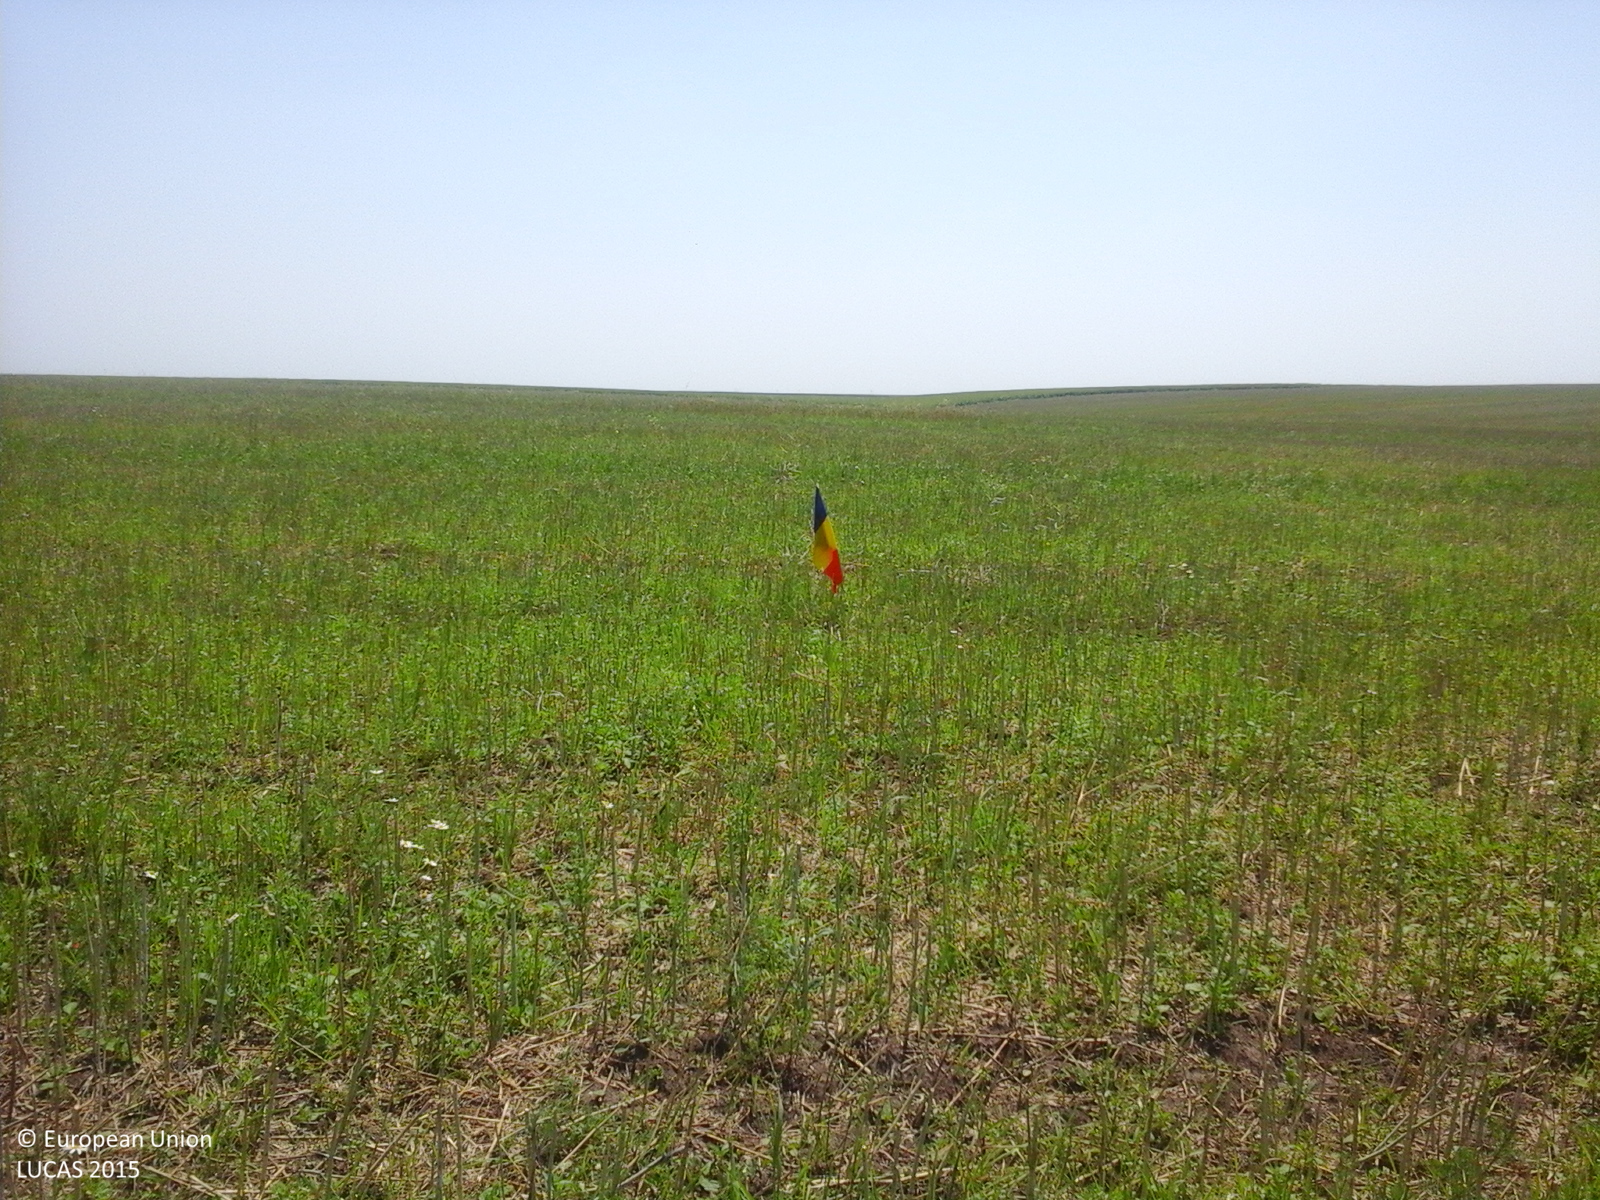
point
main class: Cropland
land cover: Rape and turnip rape
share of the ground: 10 - 25 %
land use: Agriculture (excluding fallow land and kitchen gardens)
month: July
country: RO
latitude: 44.4835
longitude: 24.8516
